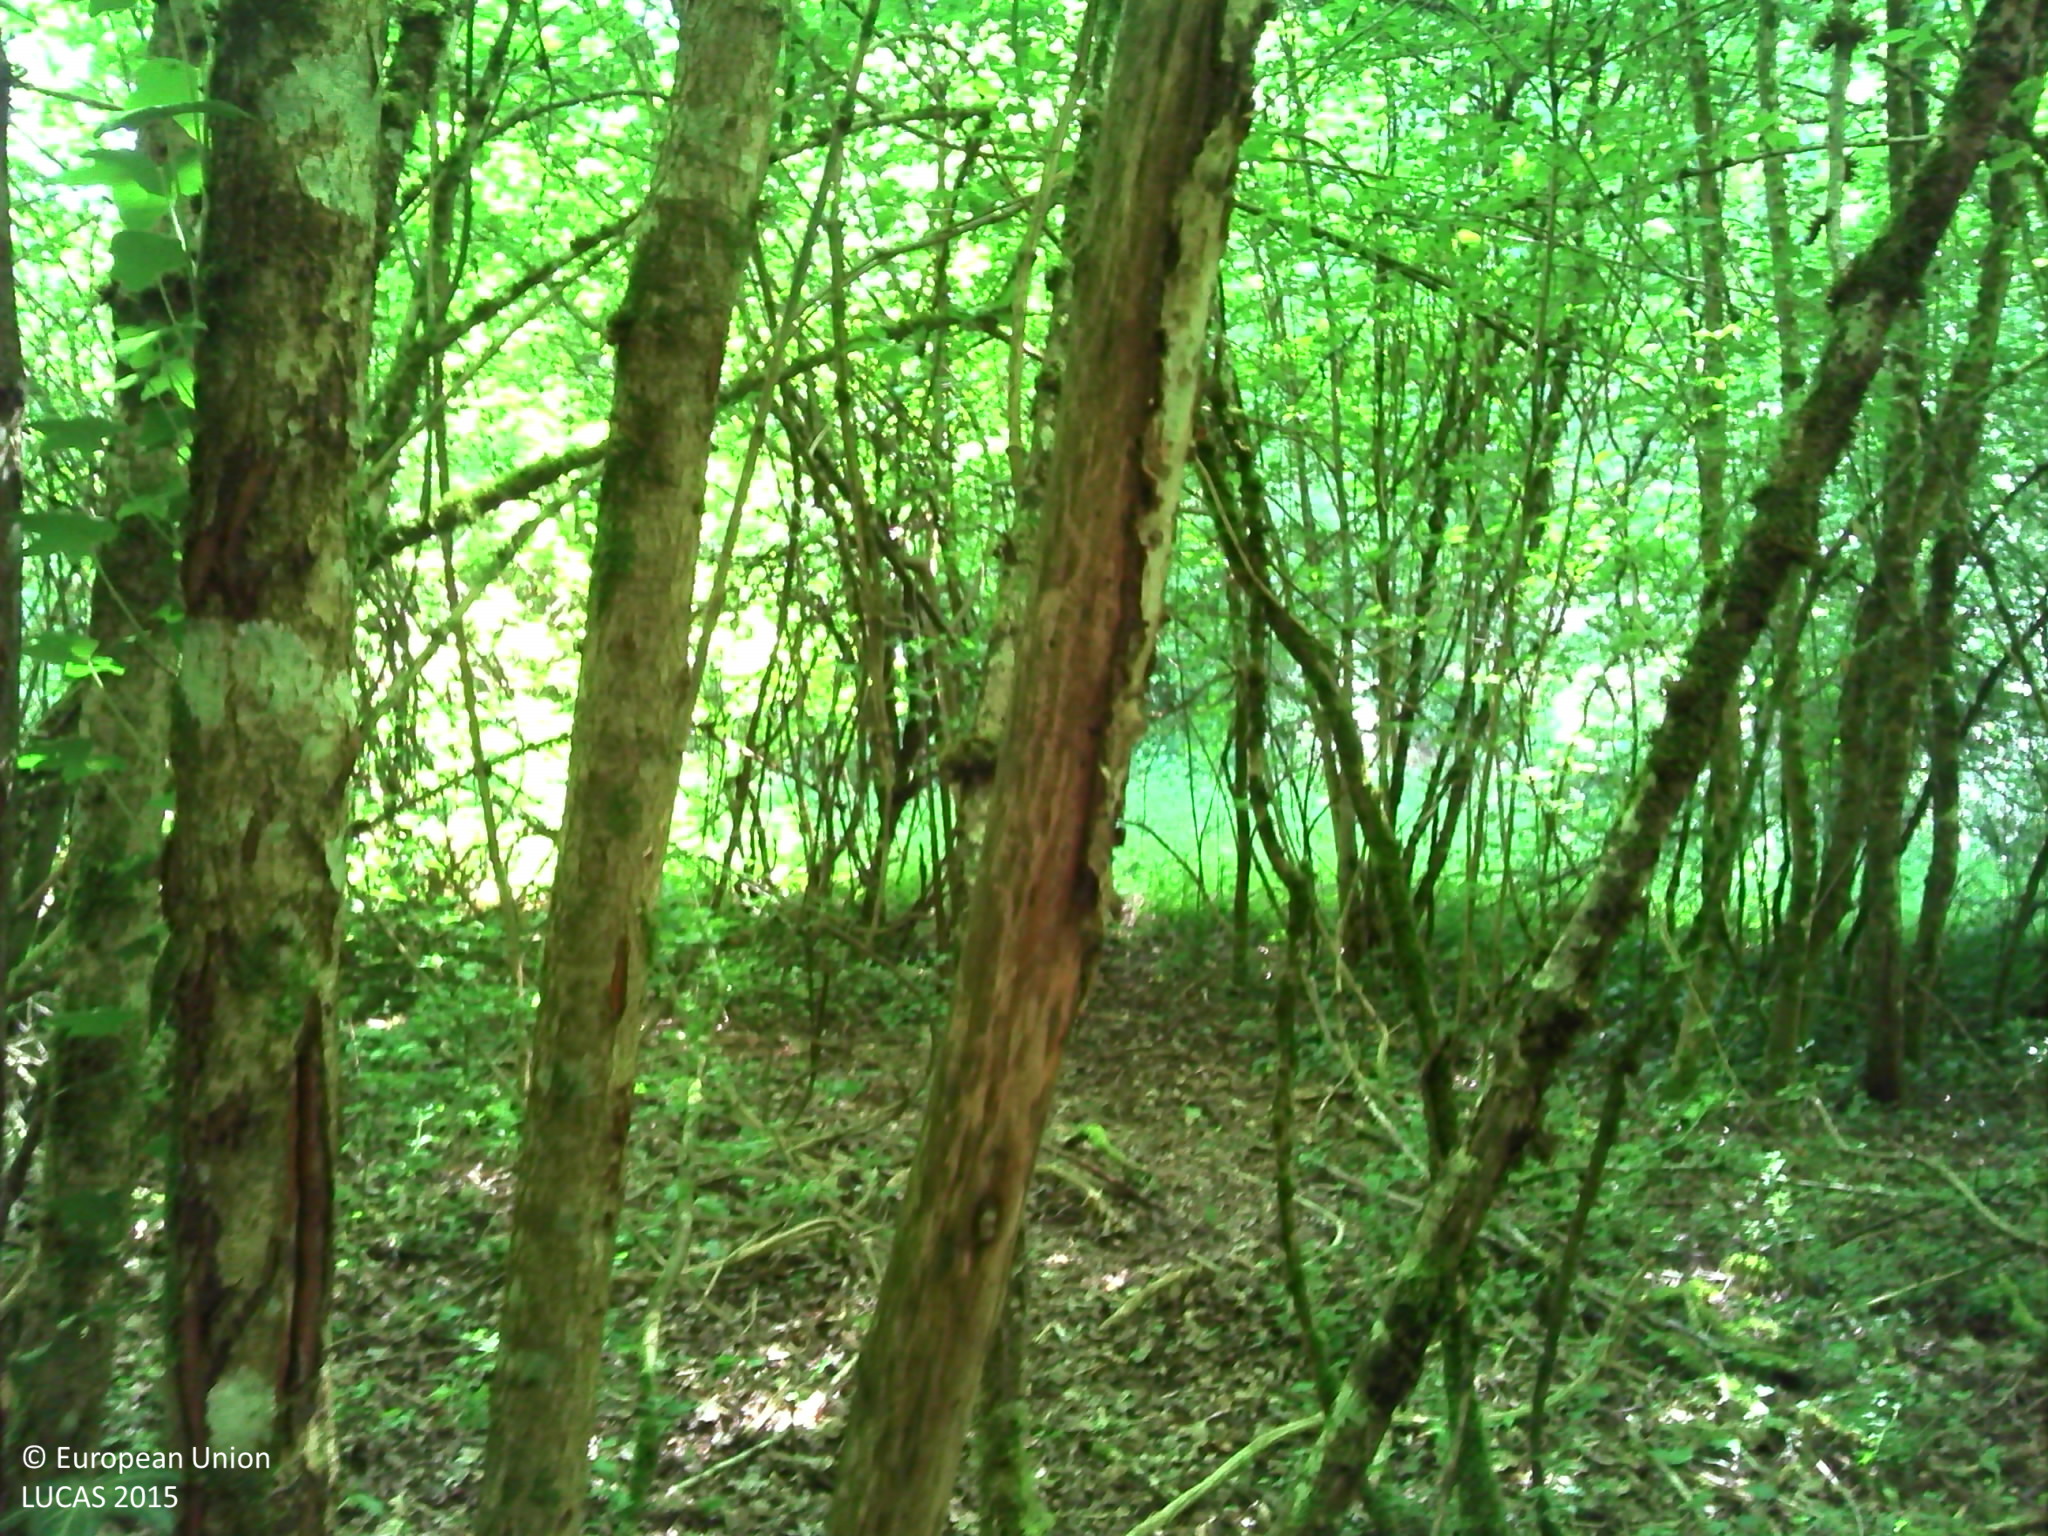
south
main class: Woodland
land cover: Broadleaved woodland
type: mesophytic deciduous forest
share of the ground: > 75 %
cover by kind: broadleaved forest trees 95 %, herbaceous plants 5 %
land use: Forestry
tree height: > 5 m
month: May
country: FR
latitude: 47.5005
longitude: 5.0751
